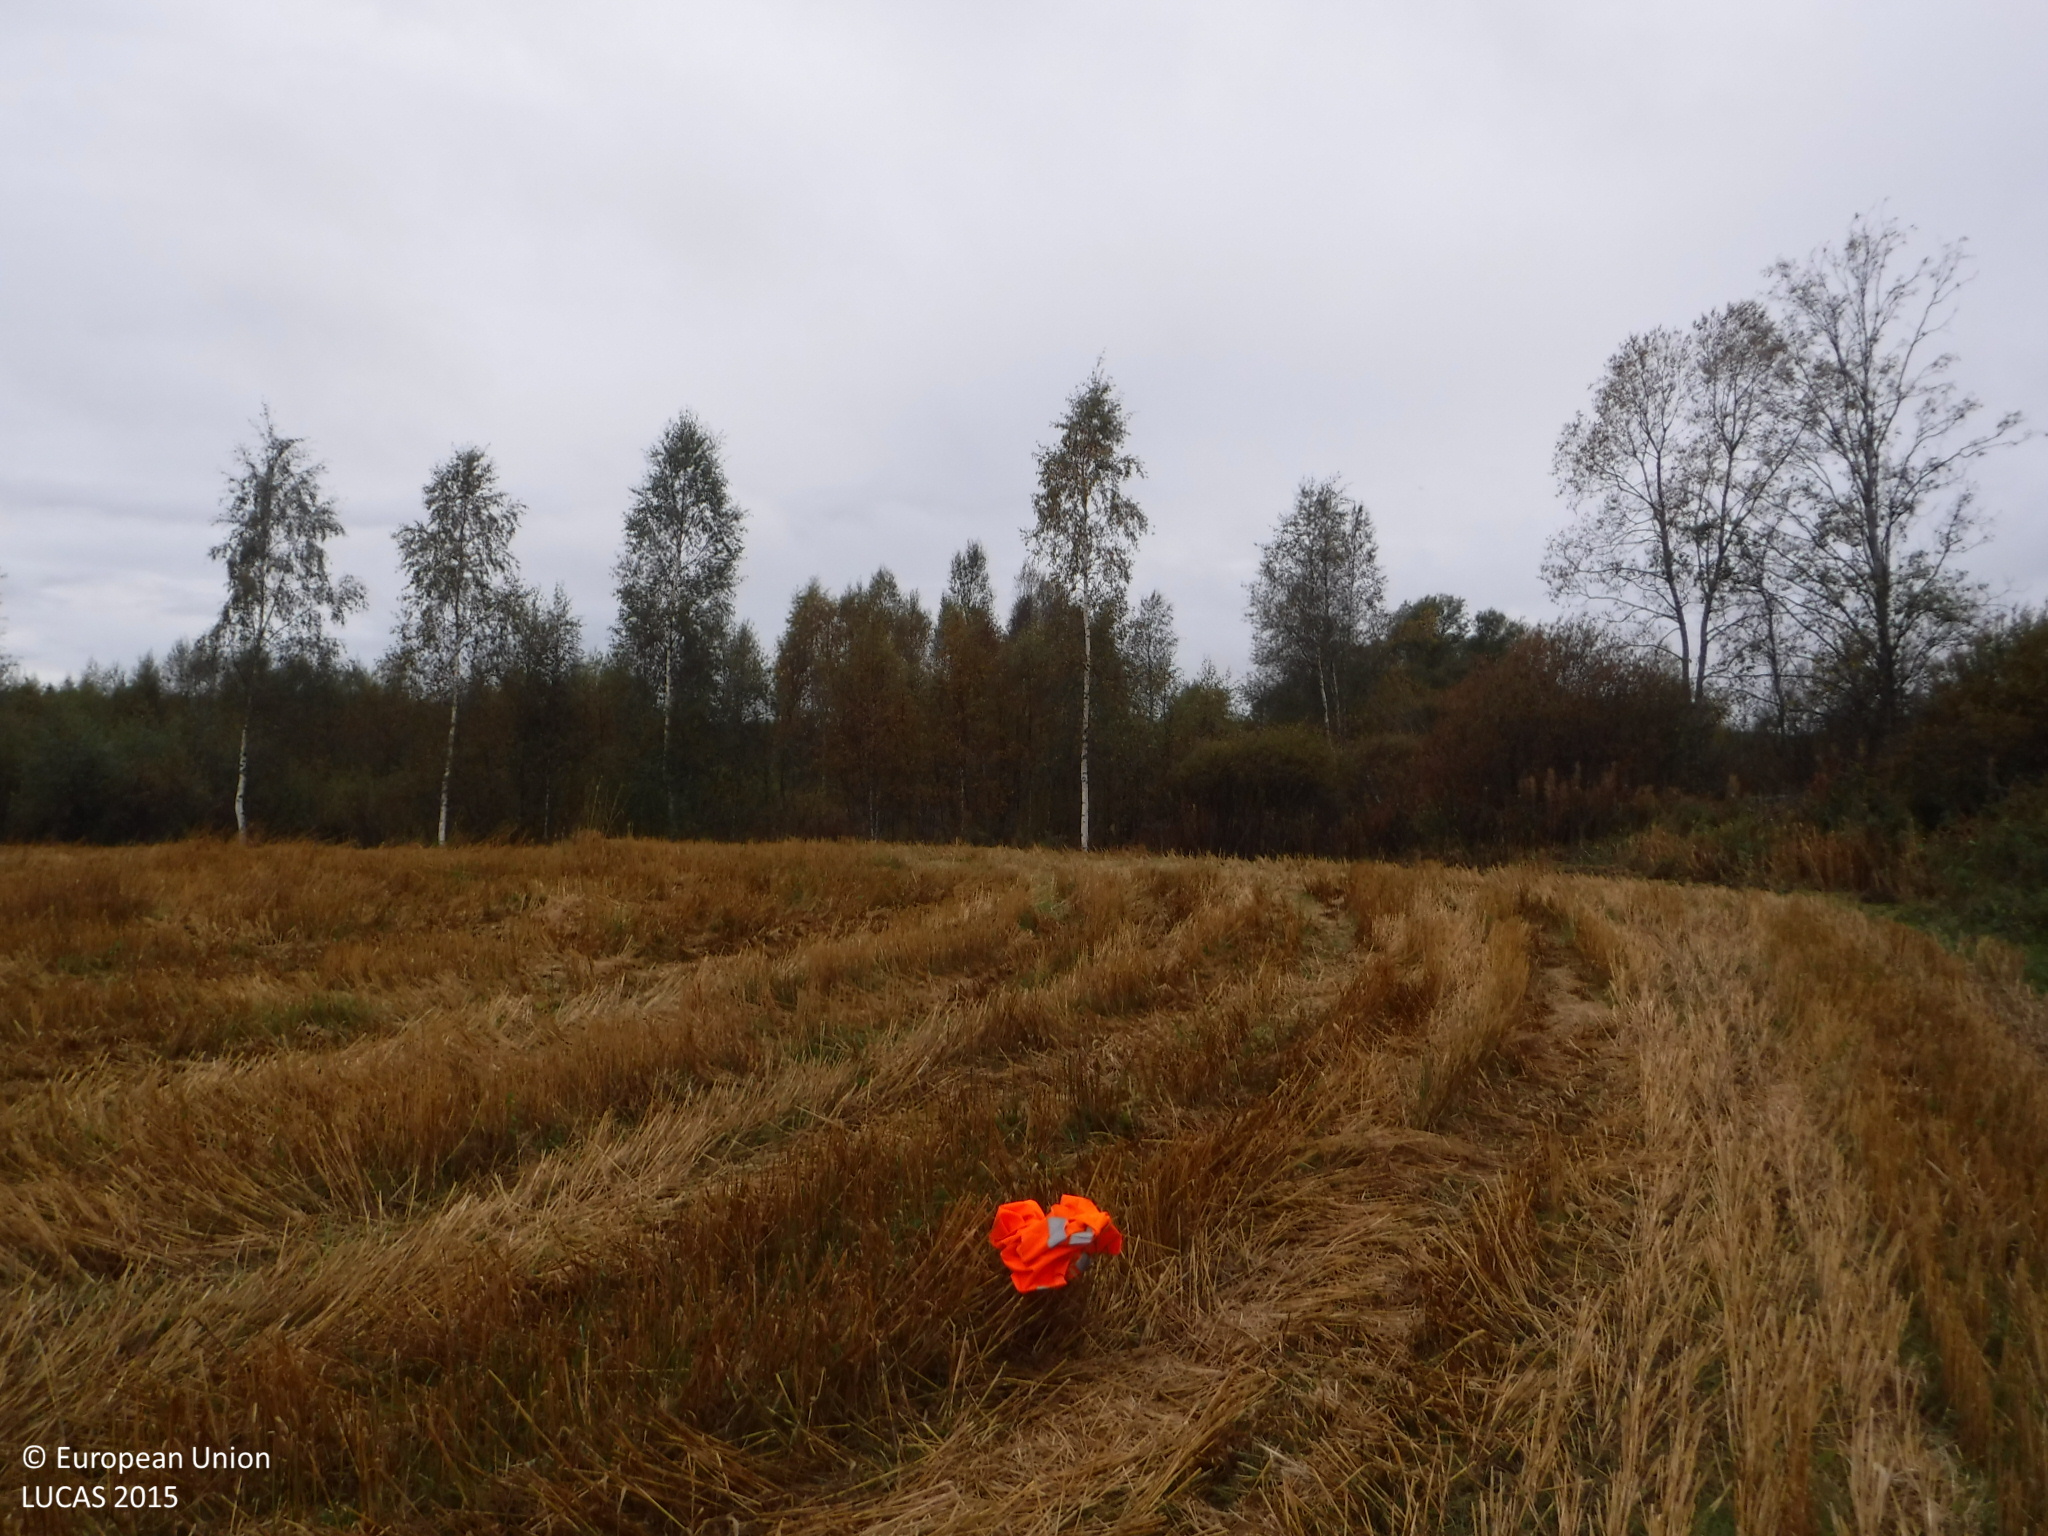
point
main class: Cropland
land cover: Oats
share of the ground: > 75 %
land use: Agriculture (excluding fallow land and kitchen gardens)
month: September
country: FI
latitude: 62.0289
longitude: 22.3463
